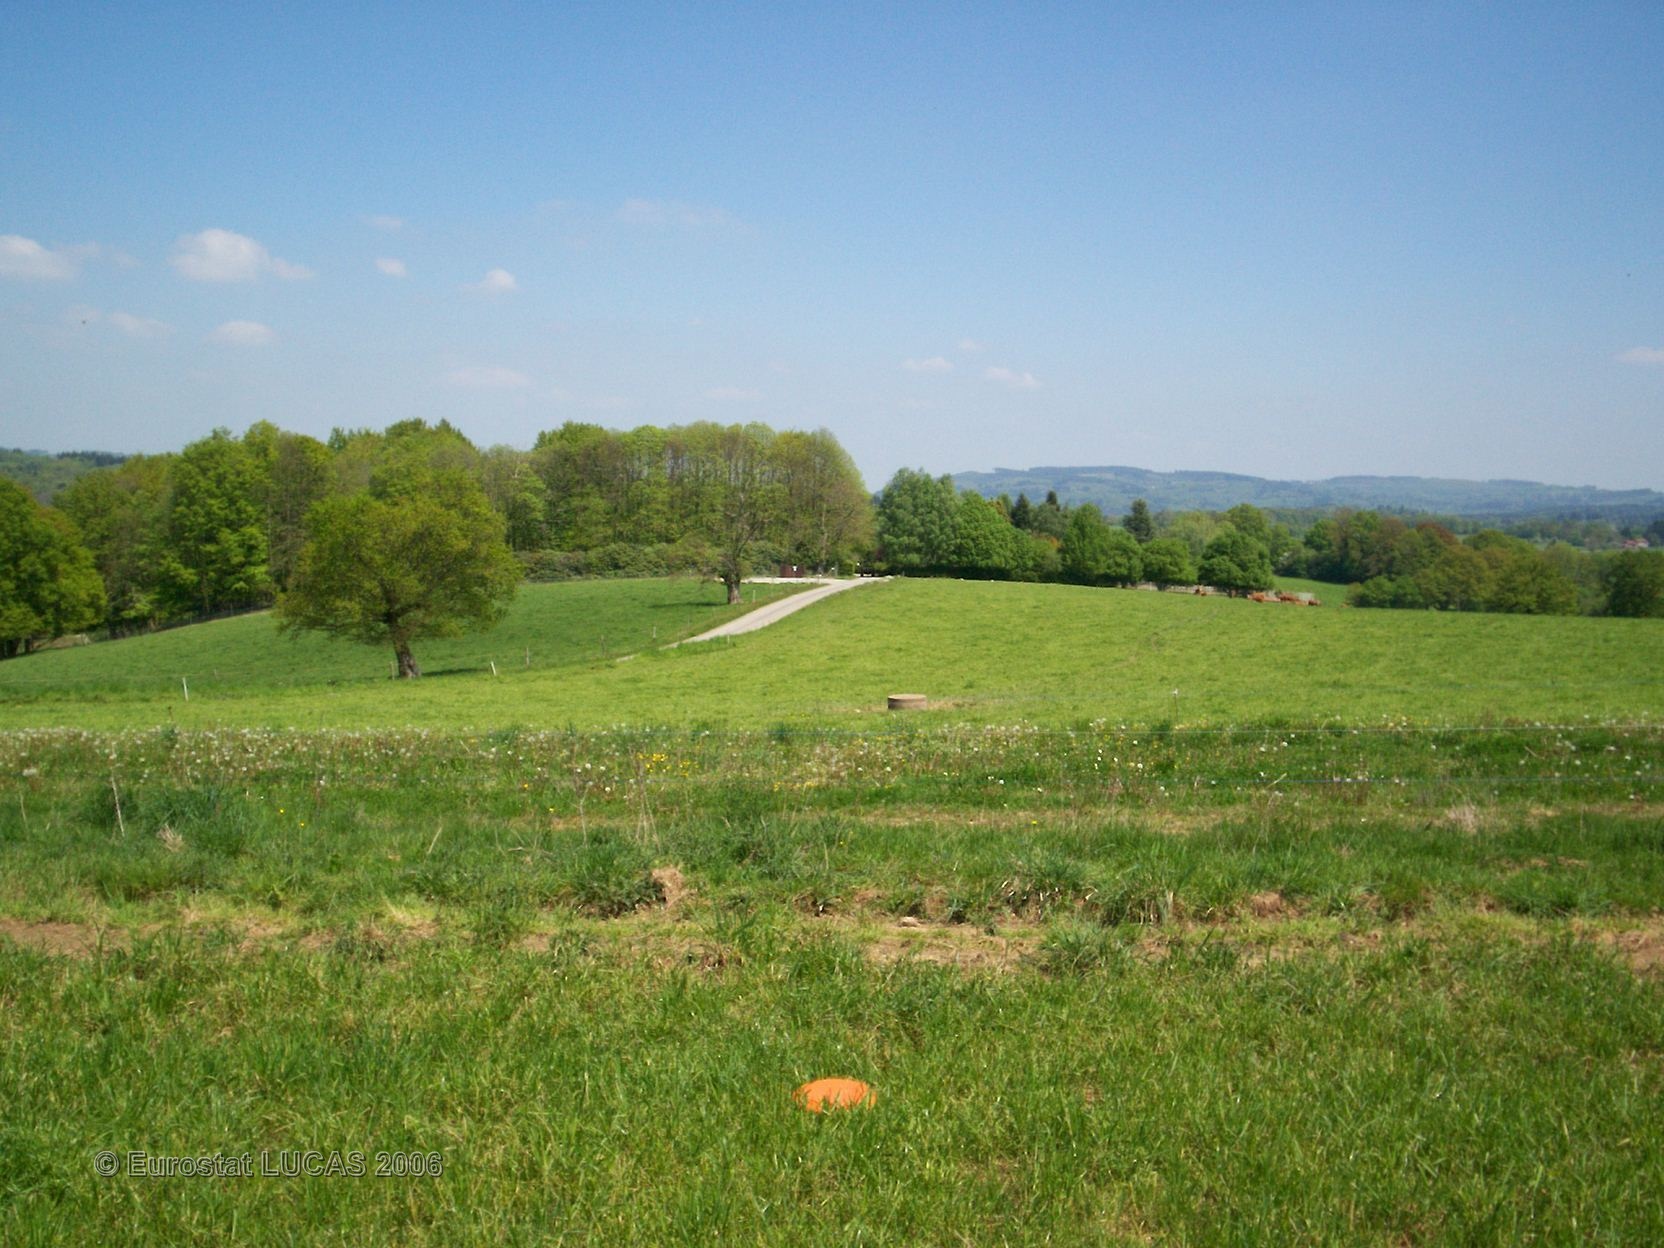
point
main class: Grassland
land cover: Grassland without tree/shrub cover
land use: Agriculture (excluding fallow land and kitchen gardens)
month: May
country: FR
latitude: 45.9792
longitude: 1.5374
